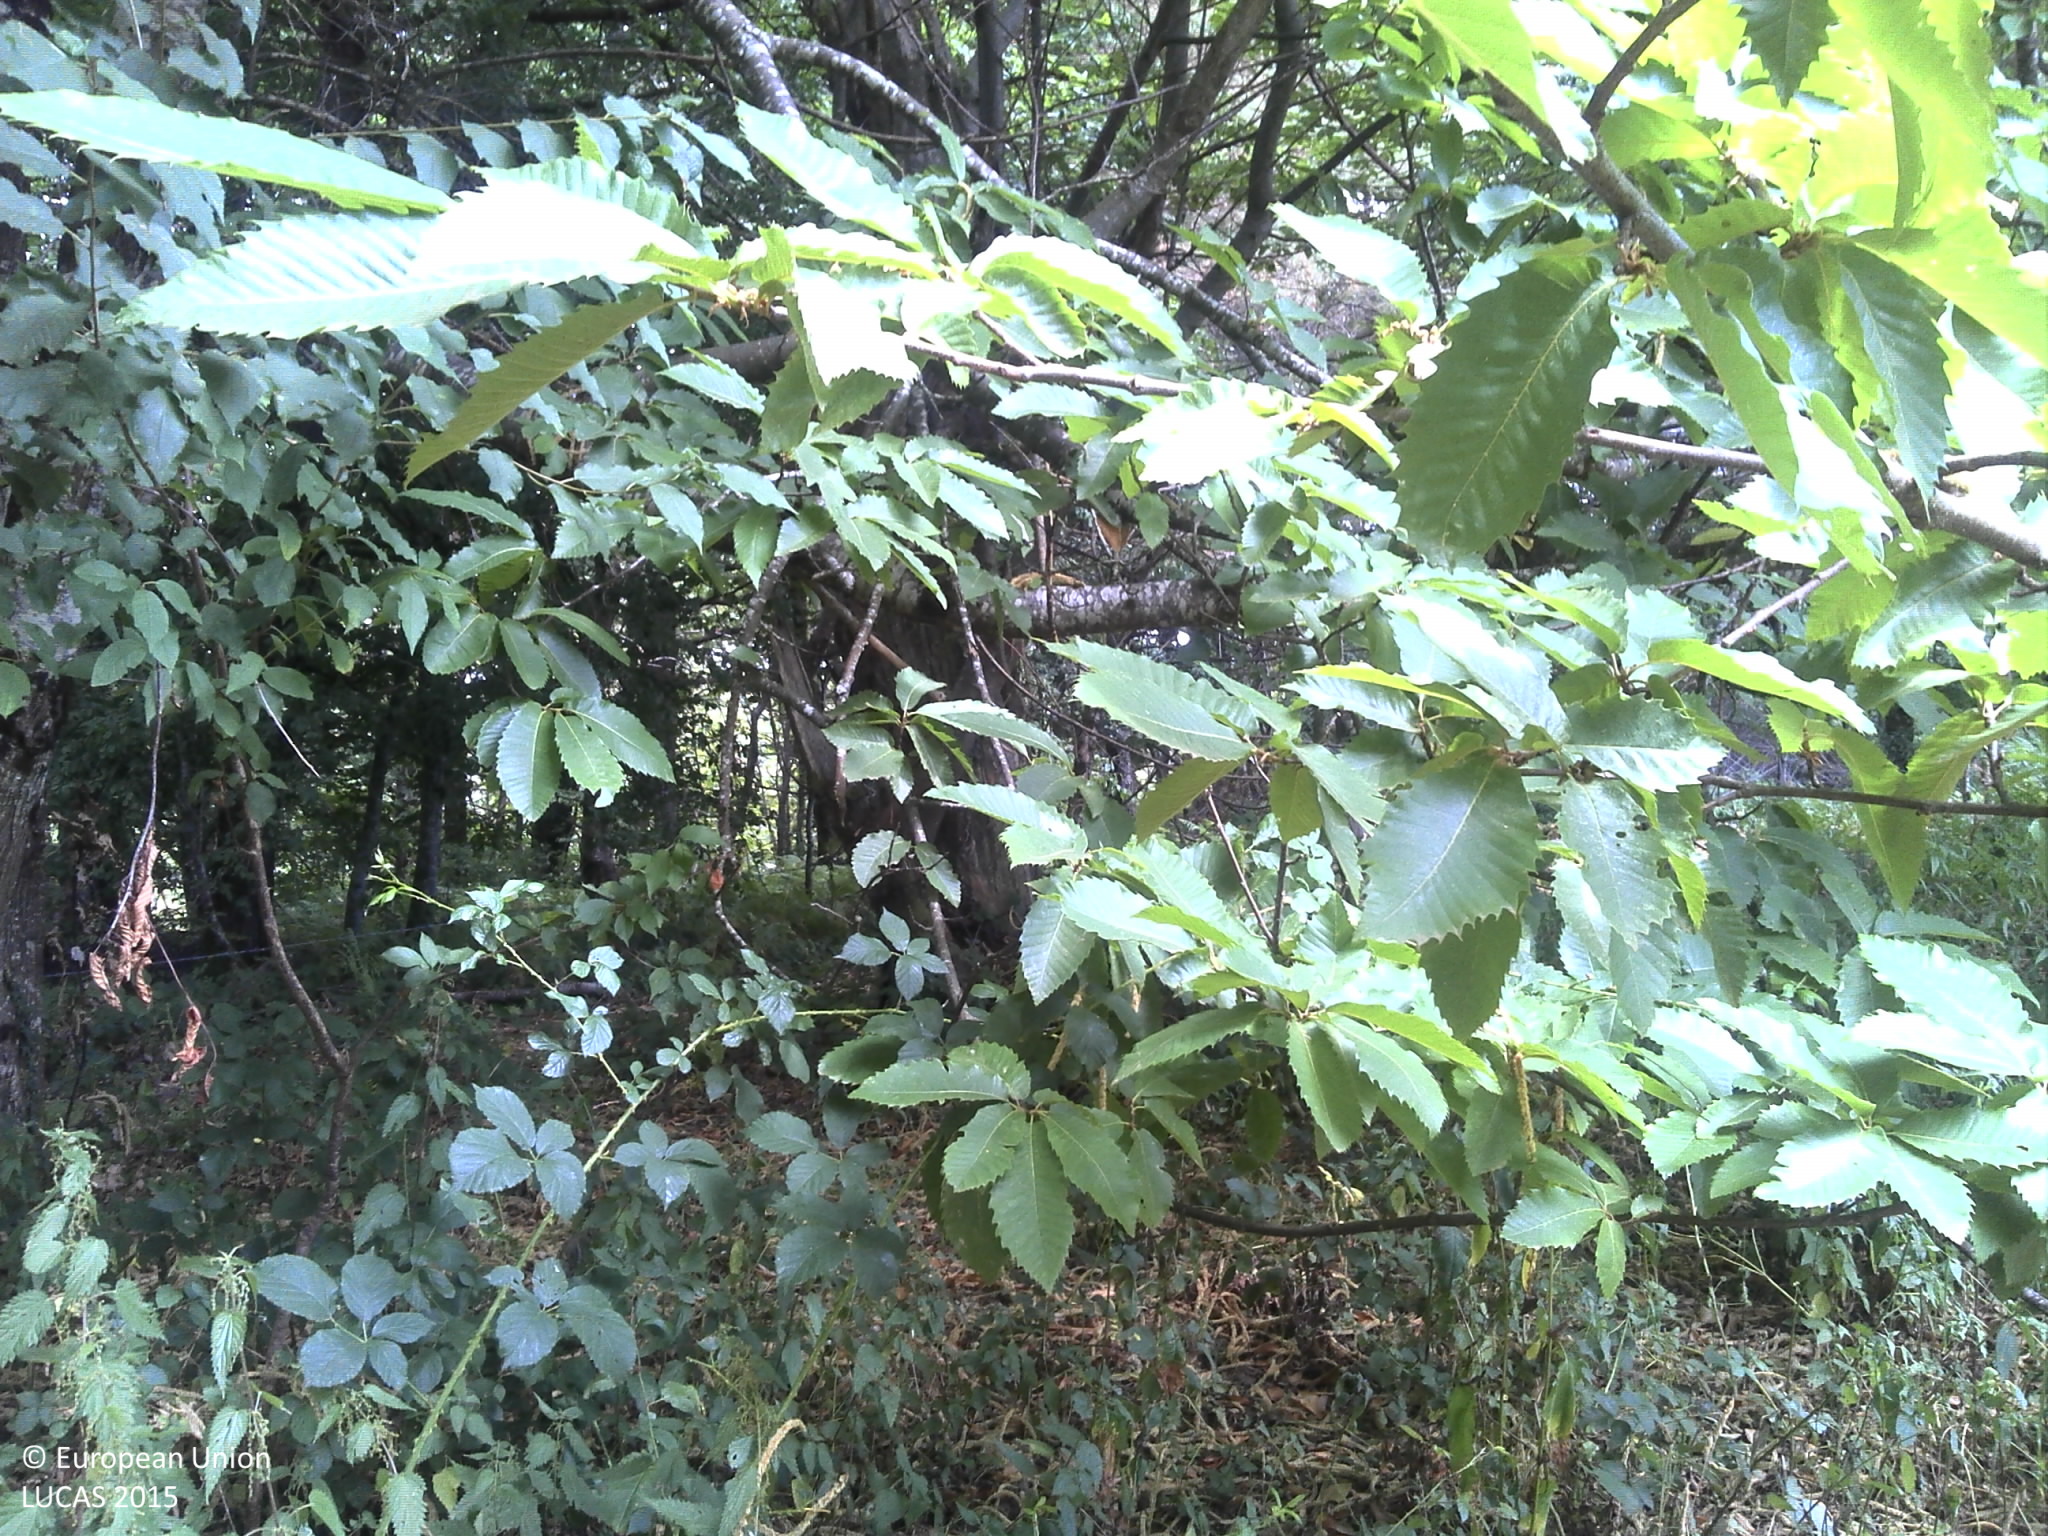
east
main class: Grassland
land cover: Grassland without tree/shrub cover
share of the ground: > 75 %
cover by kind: herbaceous plants 90 %, unconsolidated bare surface 10 %
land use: Agriculture (excluding fallow land and kitchen gardens)
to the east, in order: Grassland without tree/shrub cover; Broadleaved woodland; Fences; Tracks; Broadleaved woodland; Tracks; Broadleaved woodland; Fences; Grassland without tree/shrub cover; Fences; Lines of trees; Fences; Grassland without tree/shrub cover; Electric lines; Grassland without tree/shrub cover
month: July
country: FR
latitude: 44.9790
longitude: 1.9456
